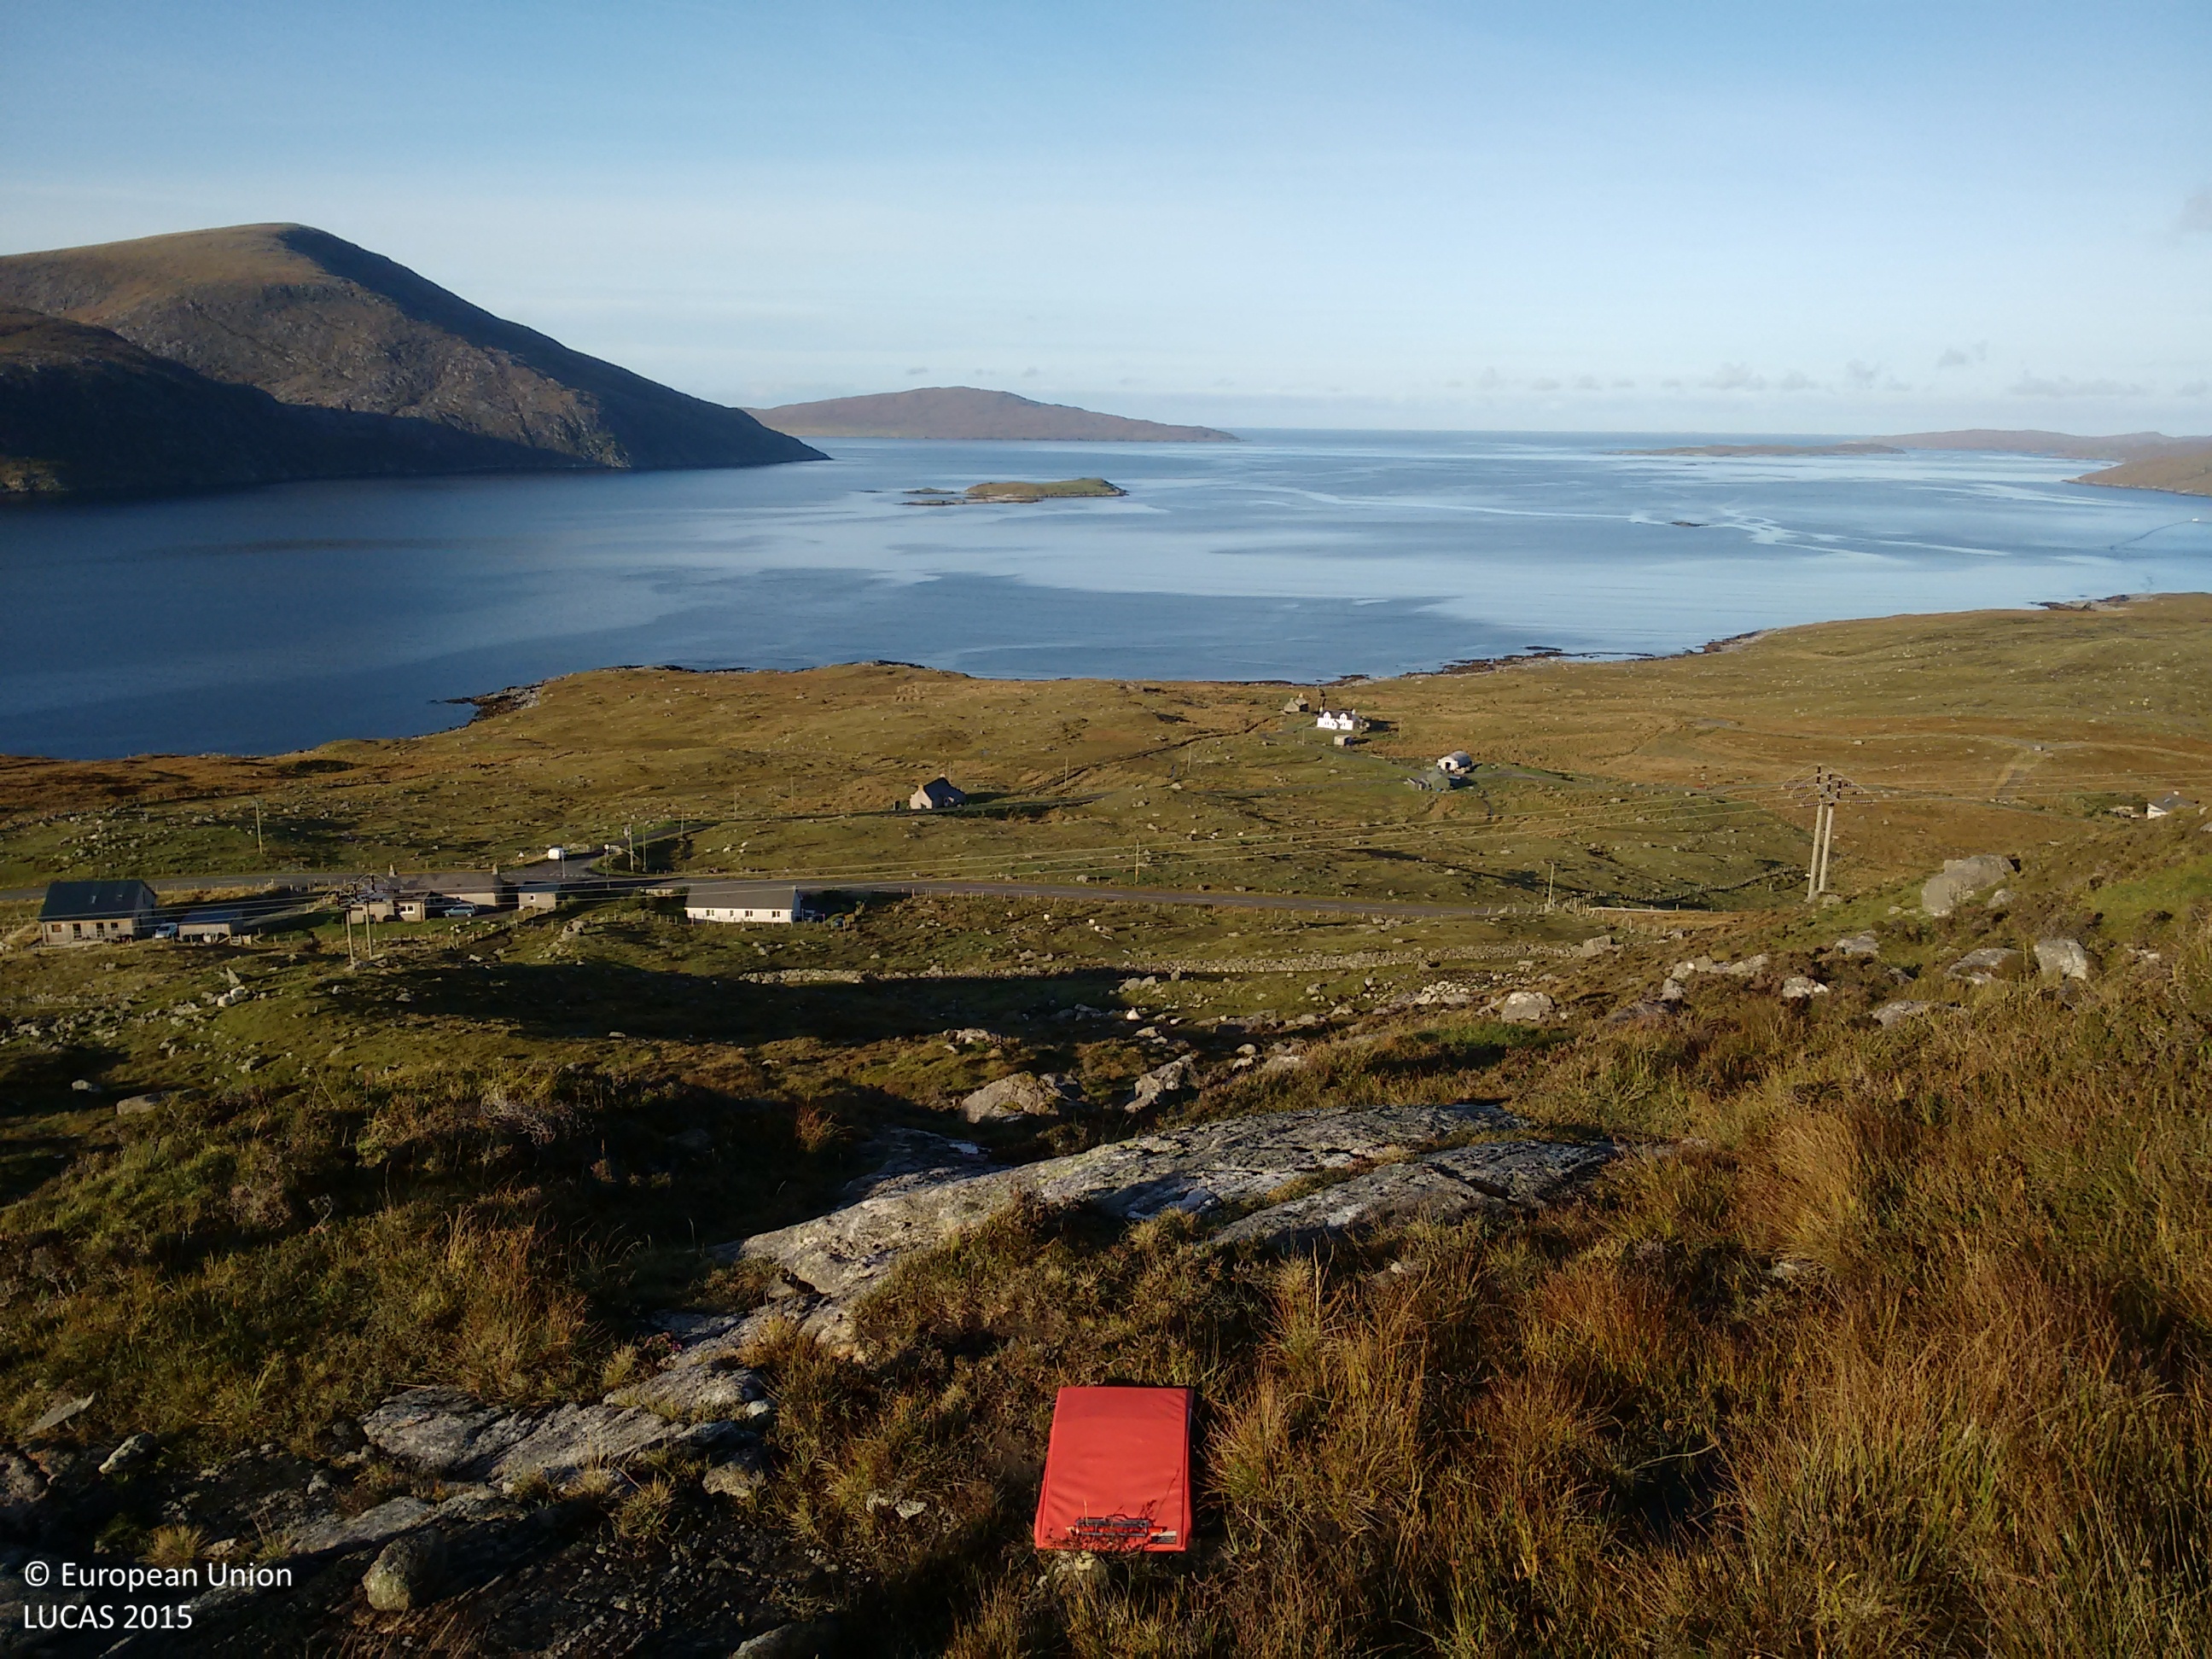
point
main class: Shrubland
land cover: Shrubland without tree cover
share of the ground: 25 - 50 %
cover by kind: herbaceous plants 40 %, shrubs 30 %
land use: Agriculture (excluding fallow land and kitchen gardens)
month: October
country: GB
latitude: 57.9187
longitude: -6.8457
